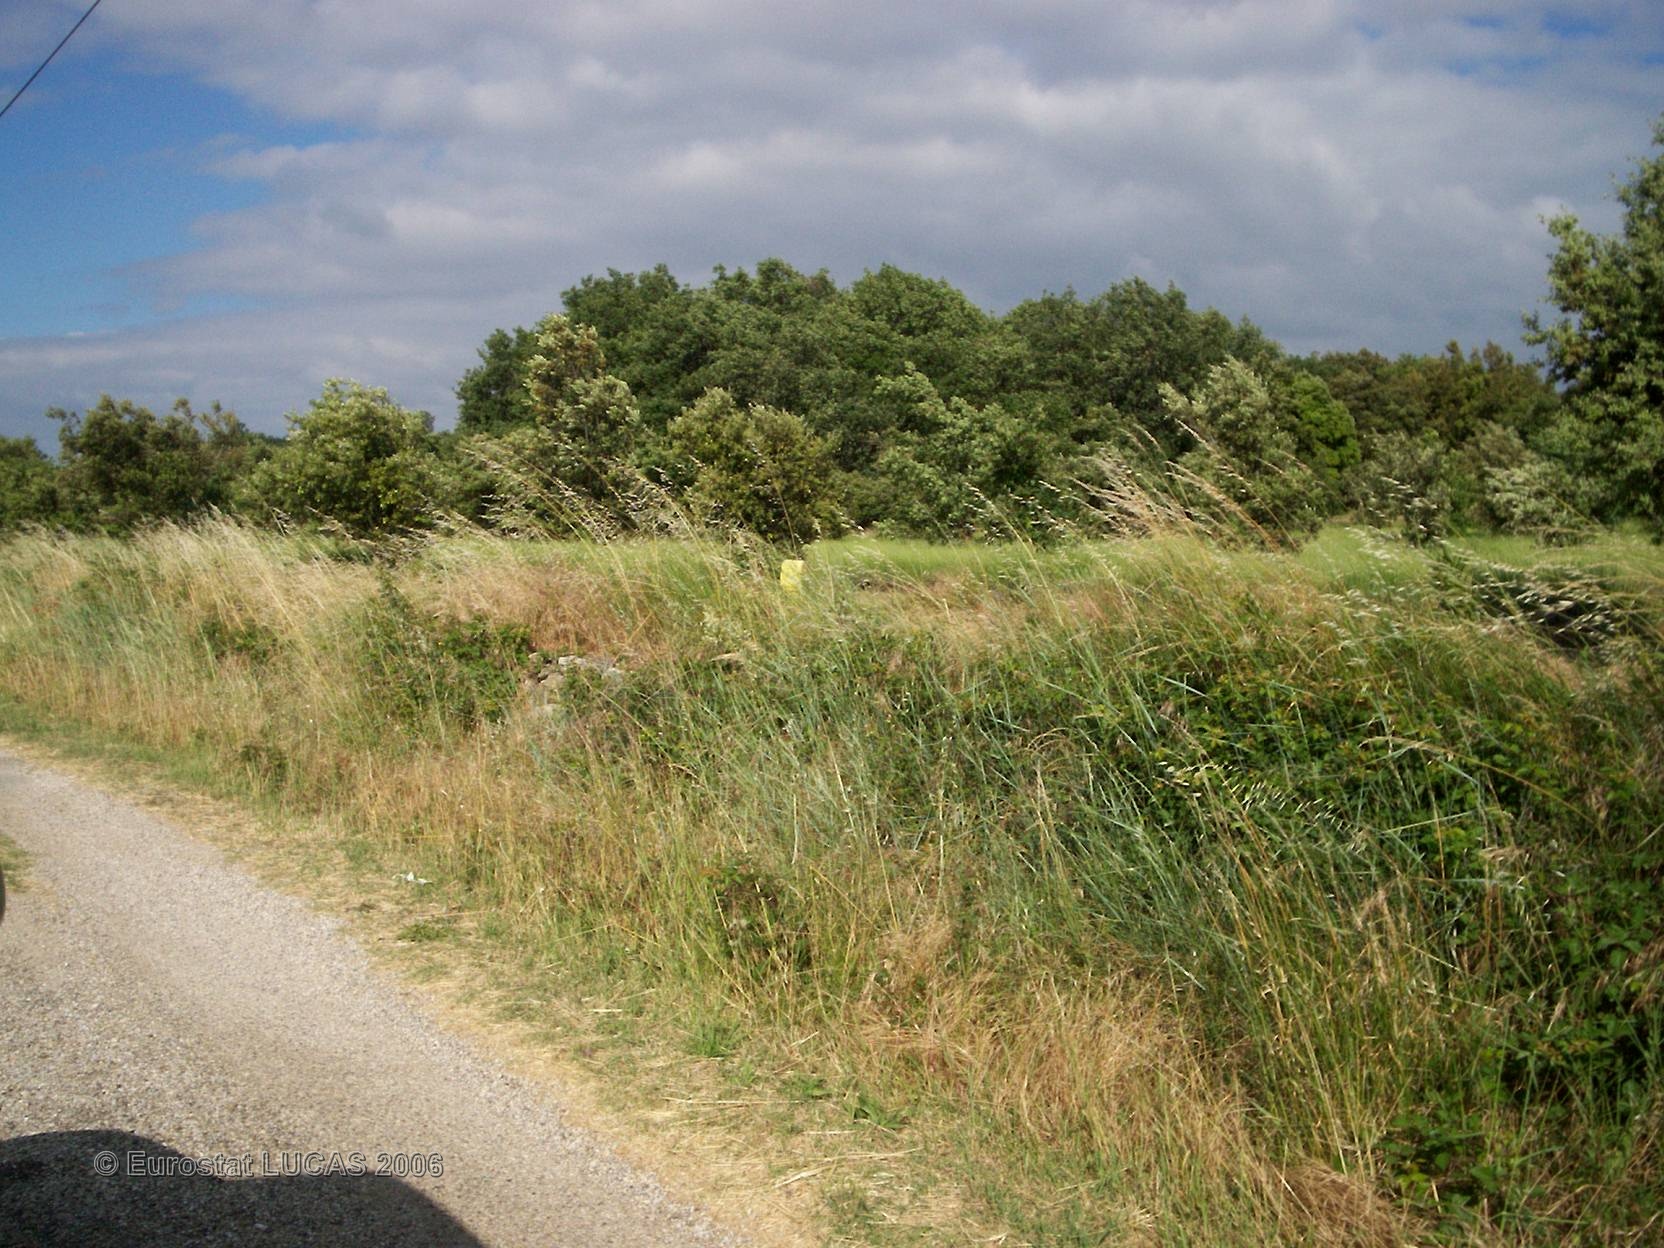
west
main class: Woodland
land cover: Broadleaved forest
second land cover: Permanent industrial crops
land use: Agriculture (excluding fallow land and kitchen gardens)
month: June
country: FR
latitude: 44.4249
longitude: 4.9200
